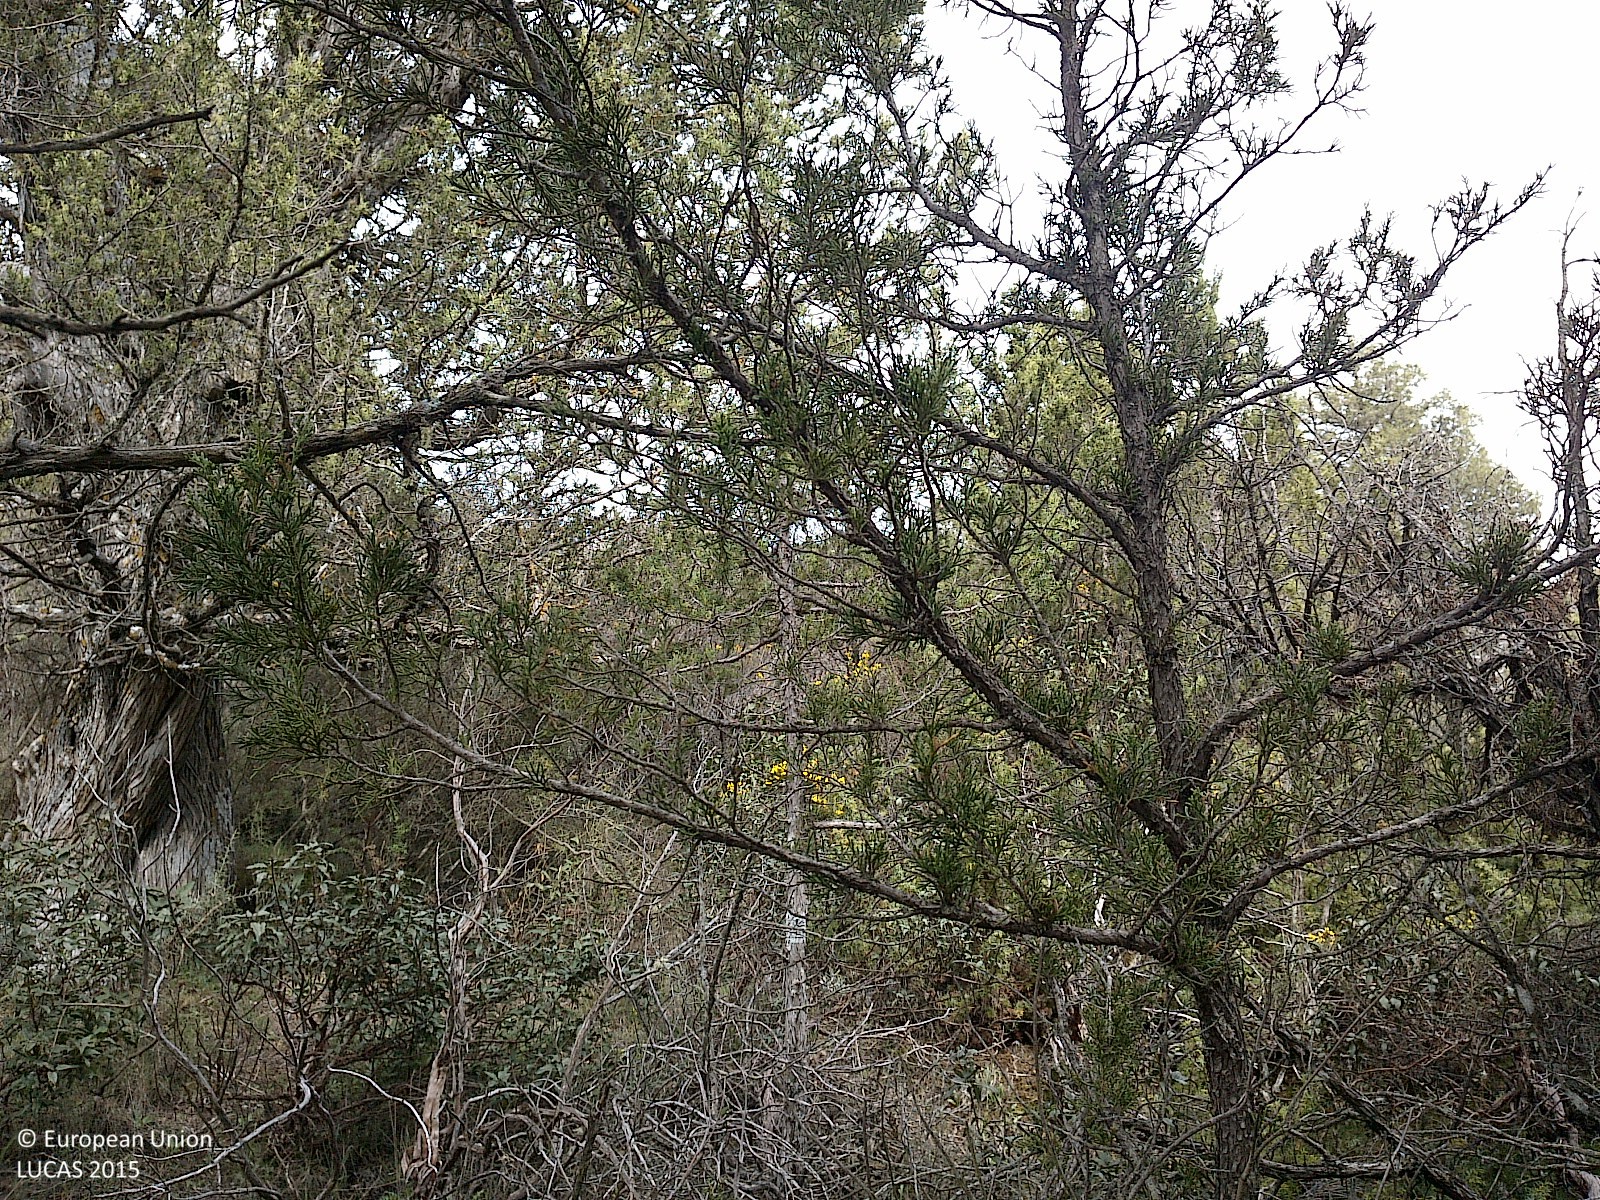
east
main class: Woodland
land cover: Other coniferous woodland
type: coniferous forest of the mediterranean region
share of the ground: 25 - 50 %
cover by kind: shrubs 65 %, coniferous forest trees 30 %, herbaceous plants 5 %
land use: Semi-natural and natural areas not in use
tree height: > 5 m
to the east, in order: Other coniferous woodland; Shrubland with sparse tree cover; Other coniferous woodland; Shrubland with sparse tree cover
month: April
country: ES
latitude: 41.6982
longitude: -3.0336
